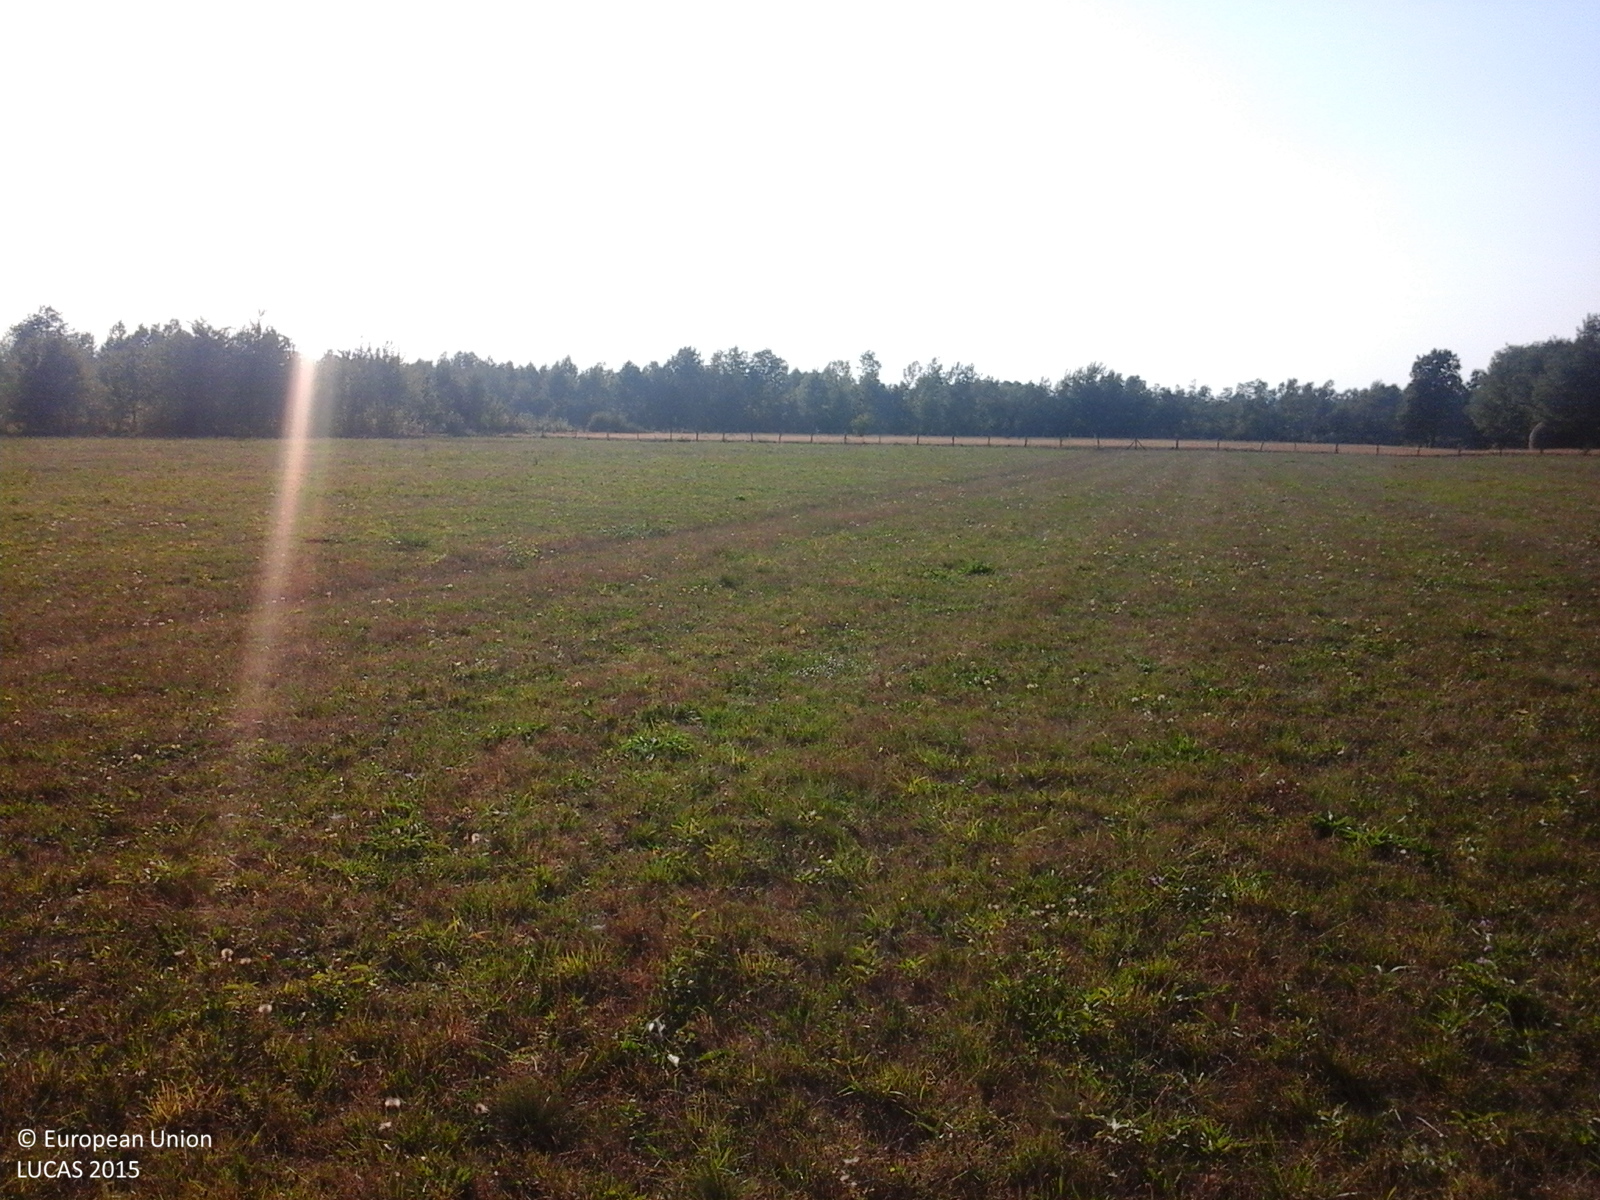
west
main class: Grassland
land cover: Grassland without tree/shrub cover
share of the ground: > 75 %
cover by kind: herbaceous plants 100 %
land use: Agriculture (excluding fallow land and kitchen gardens)
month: September
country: RO
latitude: 46.6968
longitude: 22.4360
